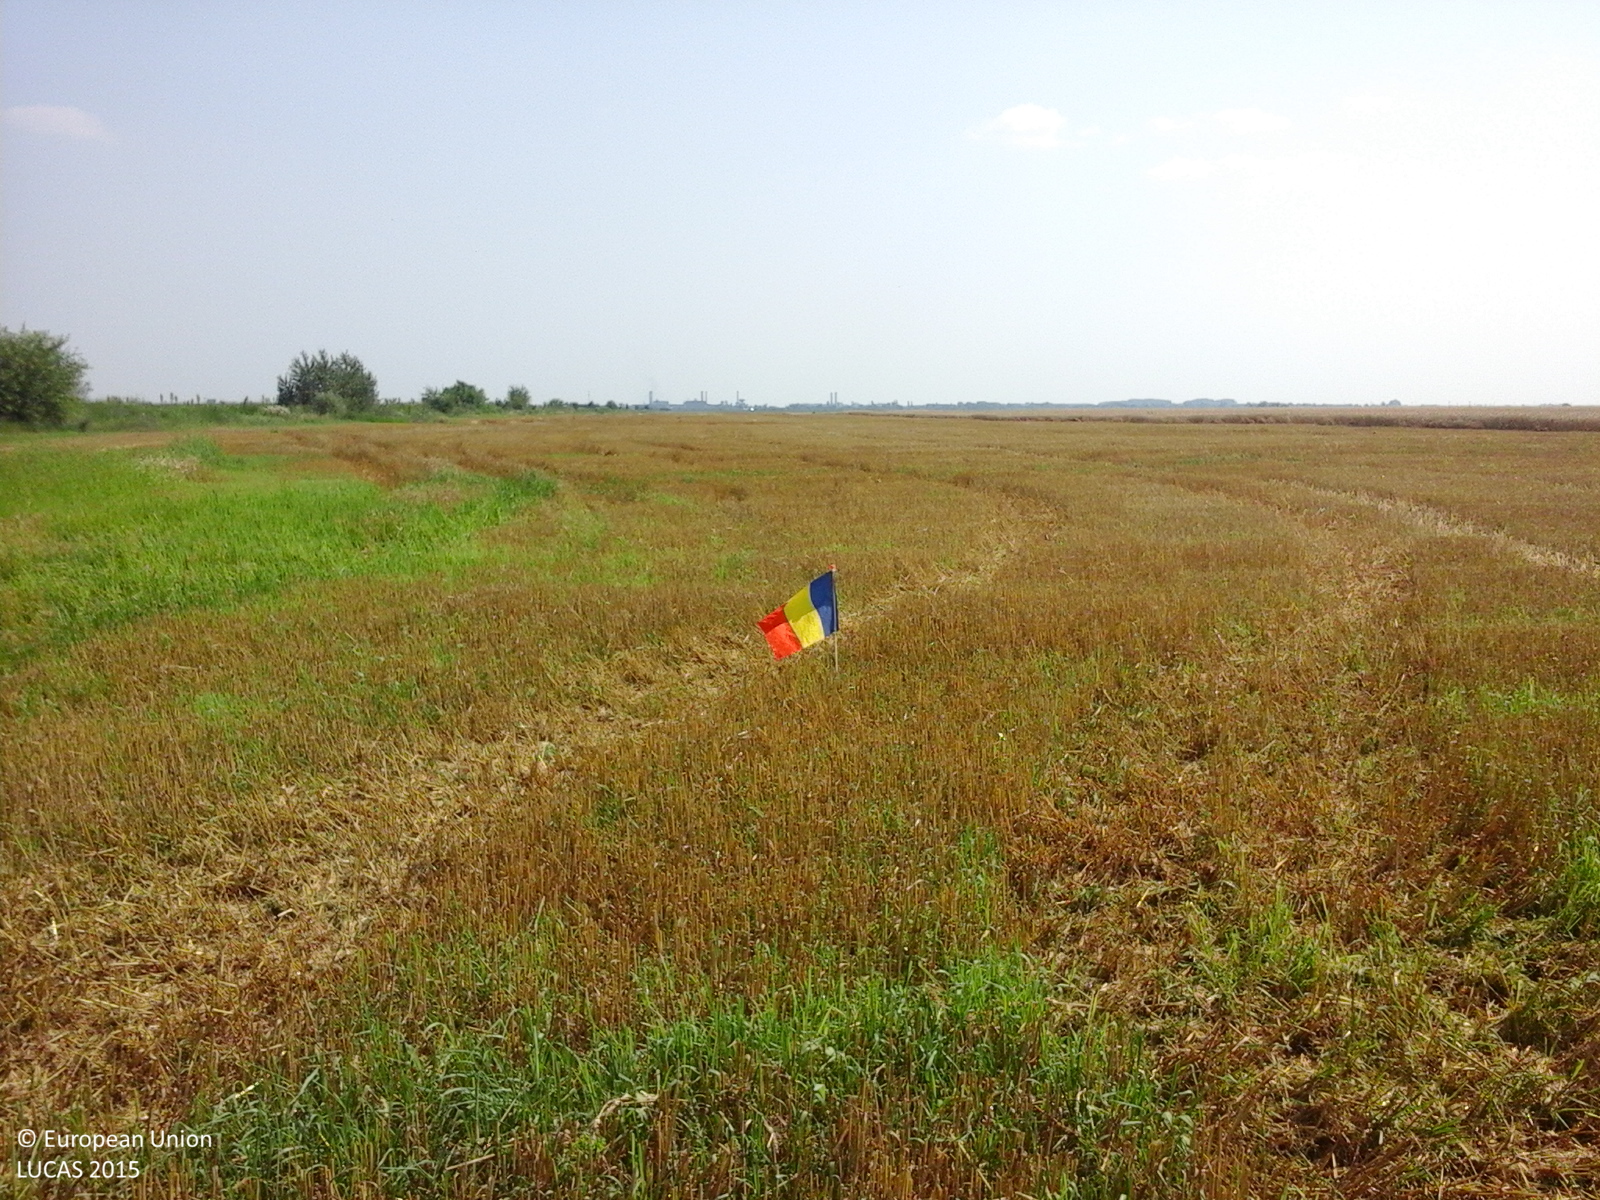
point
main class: Cropland
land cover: Common wheat
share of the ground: < 10 %
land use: Agriculture (excluding fallow land and kitchen gardens)
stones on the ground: < 10 %
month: July
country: RO
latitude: 44.7091
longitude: 25.5572
